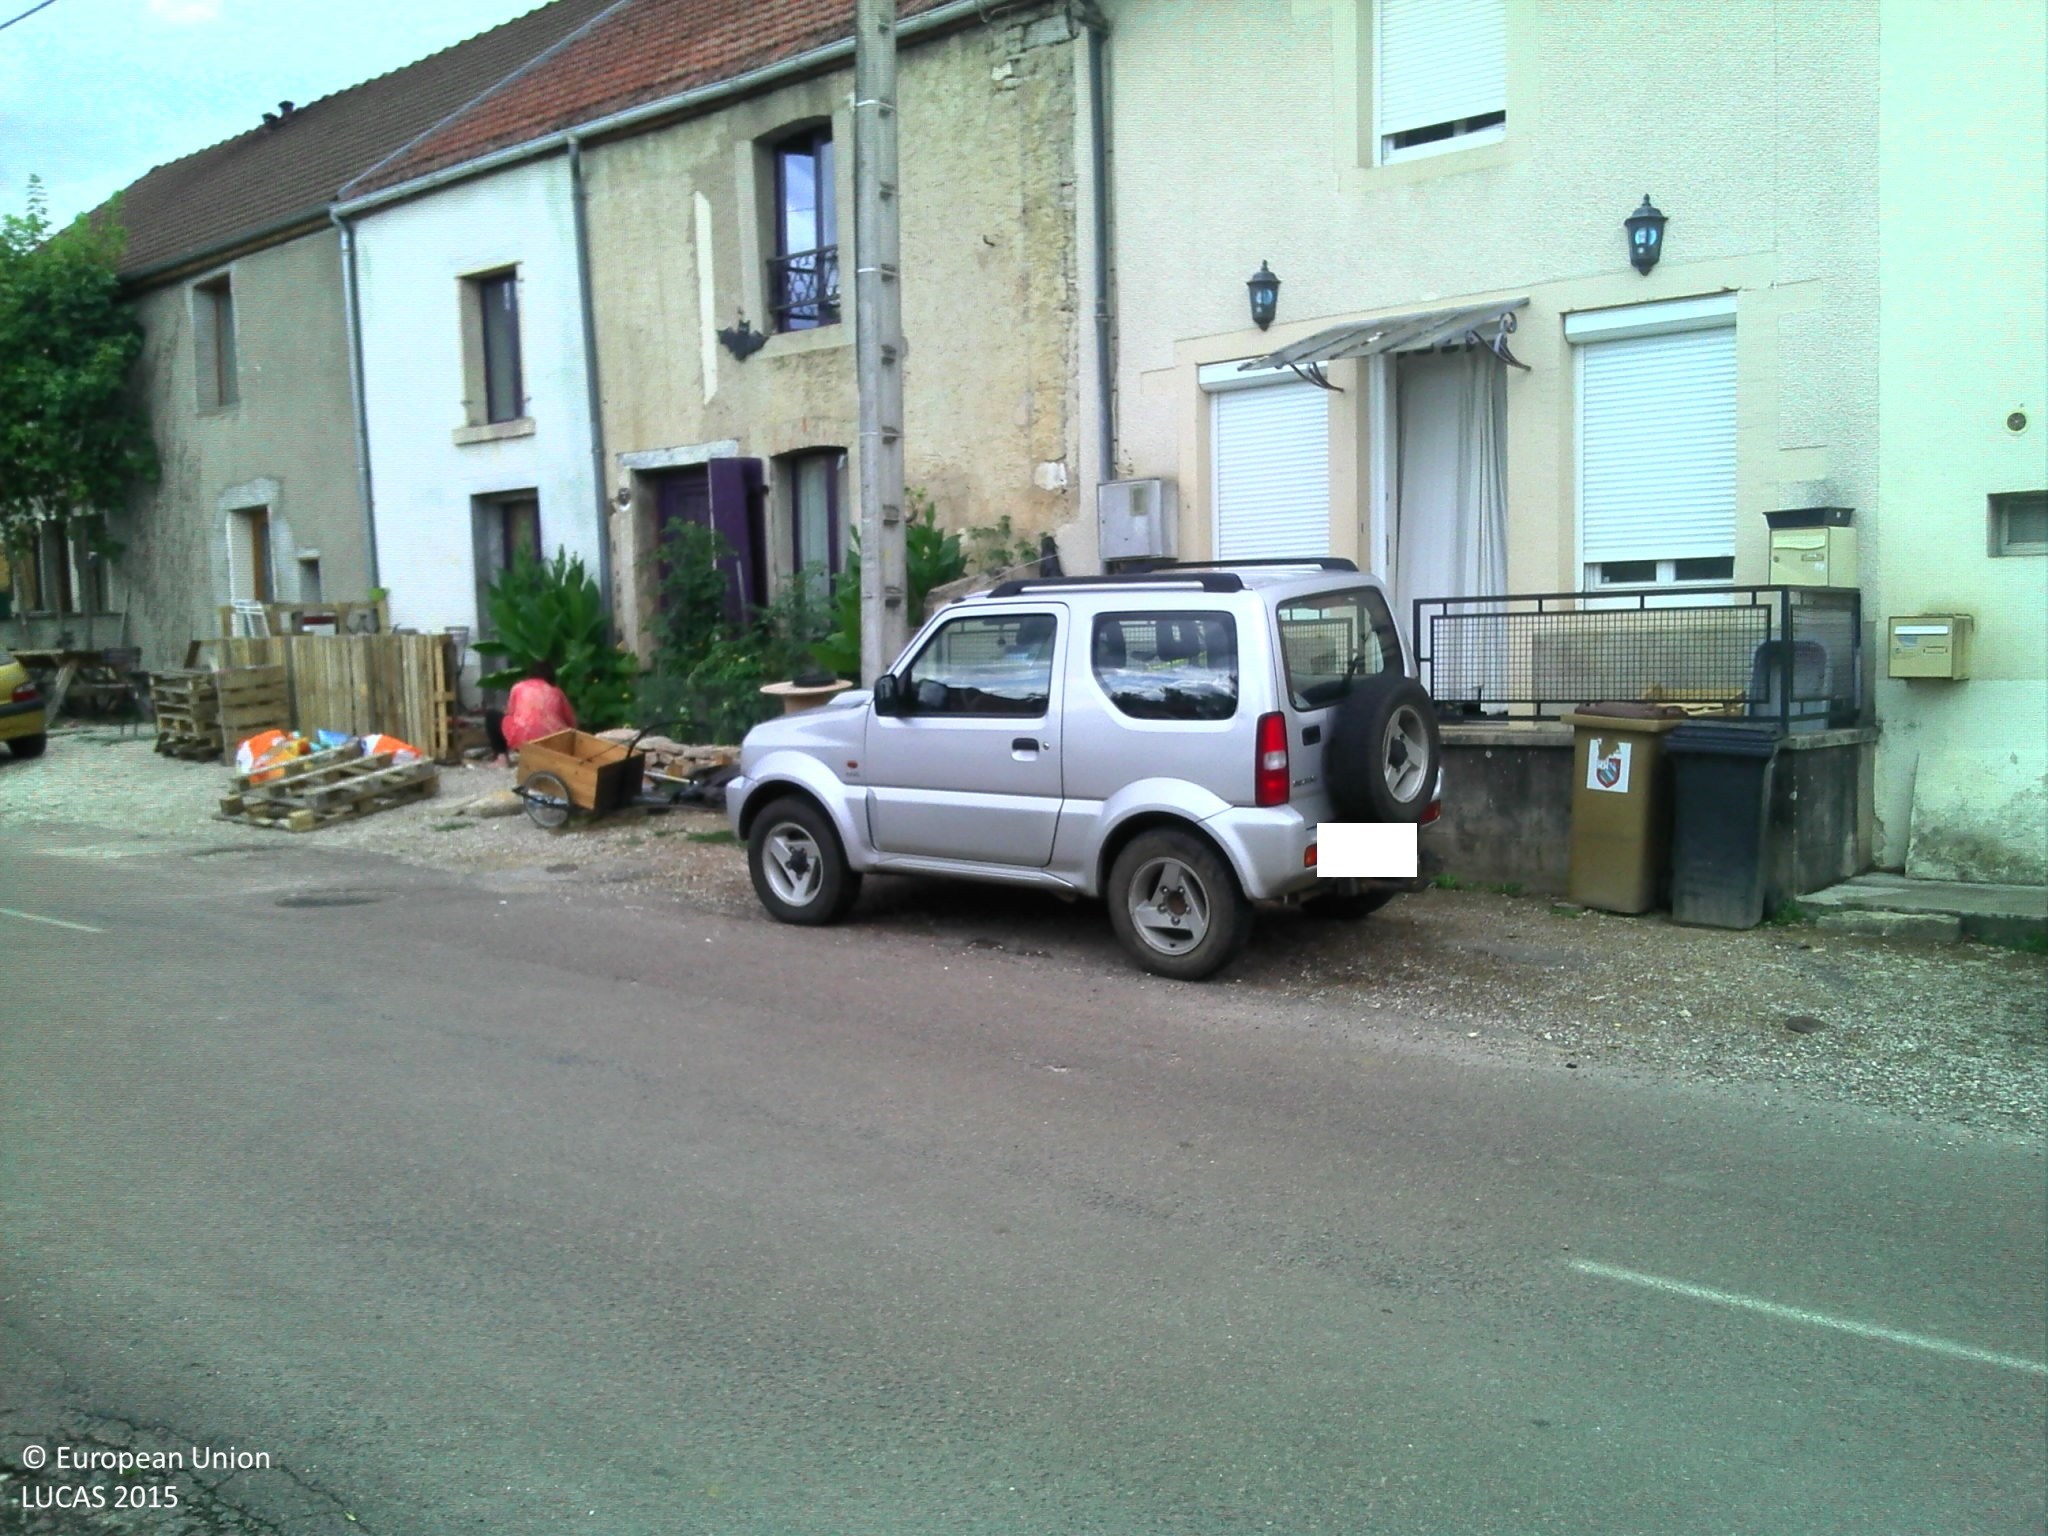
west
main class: Grassland
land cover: Grassland with sparse tree/shrub cover
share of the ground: > 75 %
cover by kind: herbaceous plants 95 %, broadleaved forest trees 5 %
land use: Residential
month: August
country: FR
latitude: 47.3254
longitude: 4.8001
